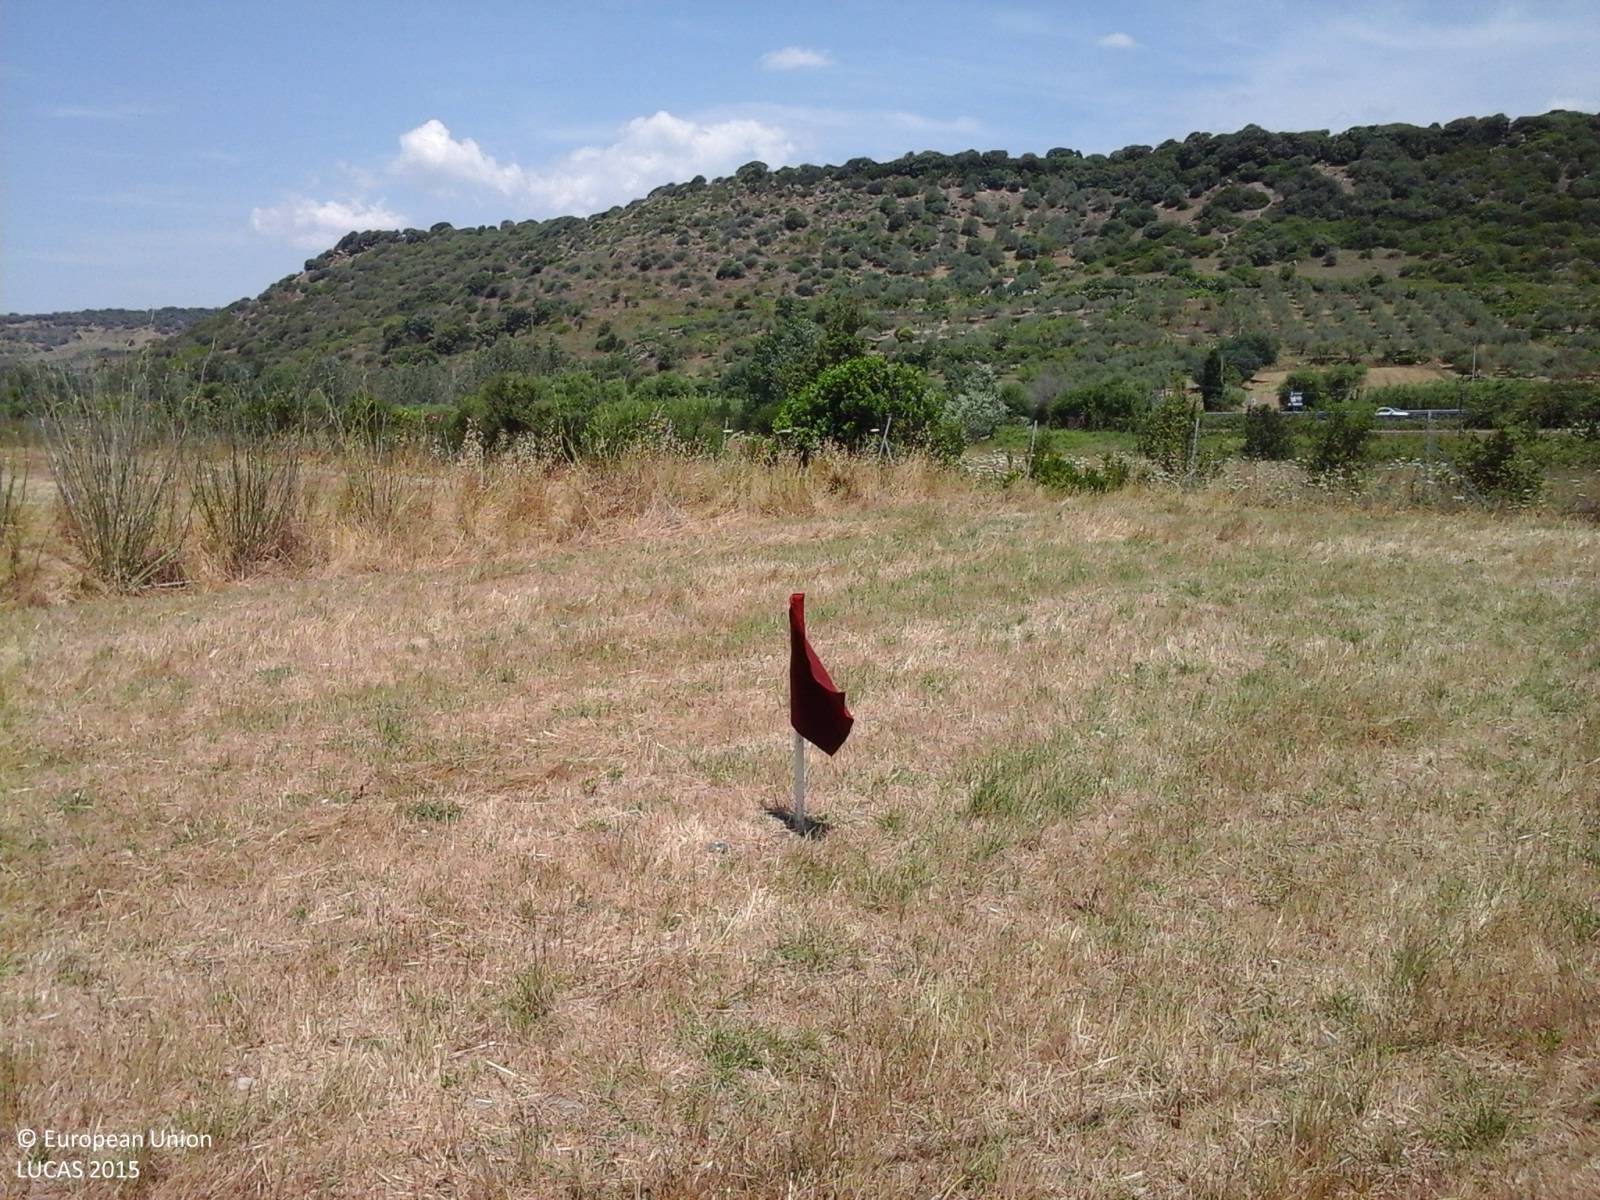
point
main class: Grassland
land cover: Grassland without tree/shrub cover
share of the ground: 25 - 50 %
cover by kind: herbaceous plants 100 %
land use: Agriculture (excluding fallow land and kitchen gardens)
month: June
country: IT
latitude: 40.5851
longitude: 8.7421
